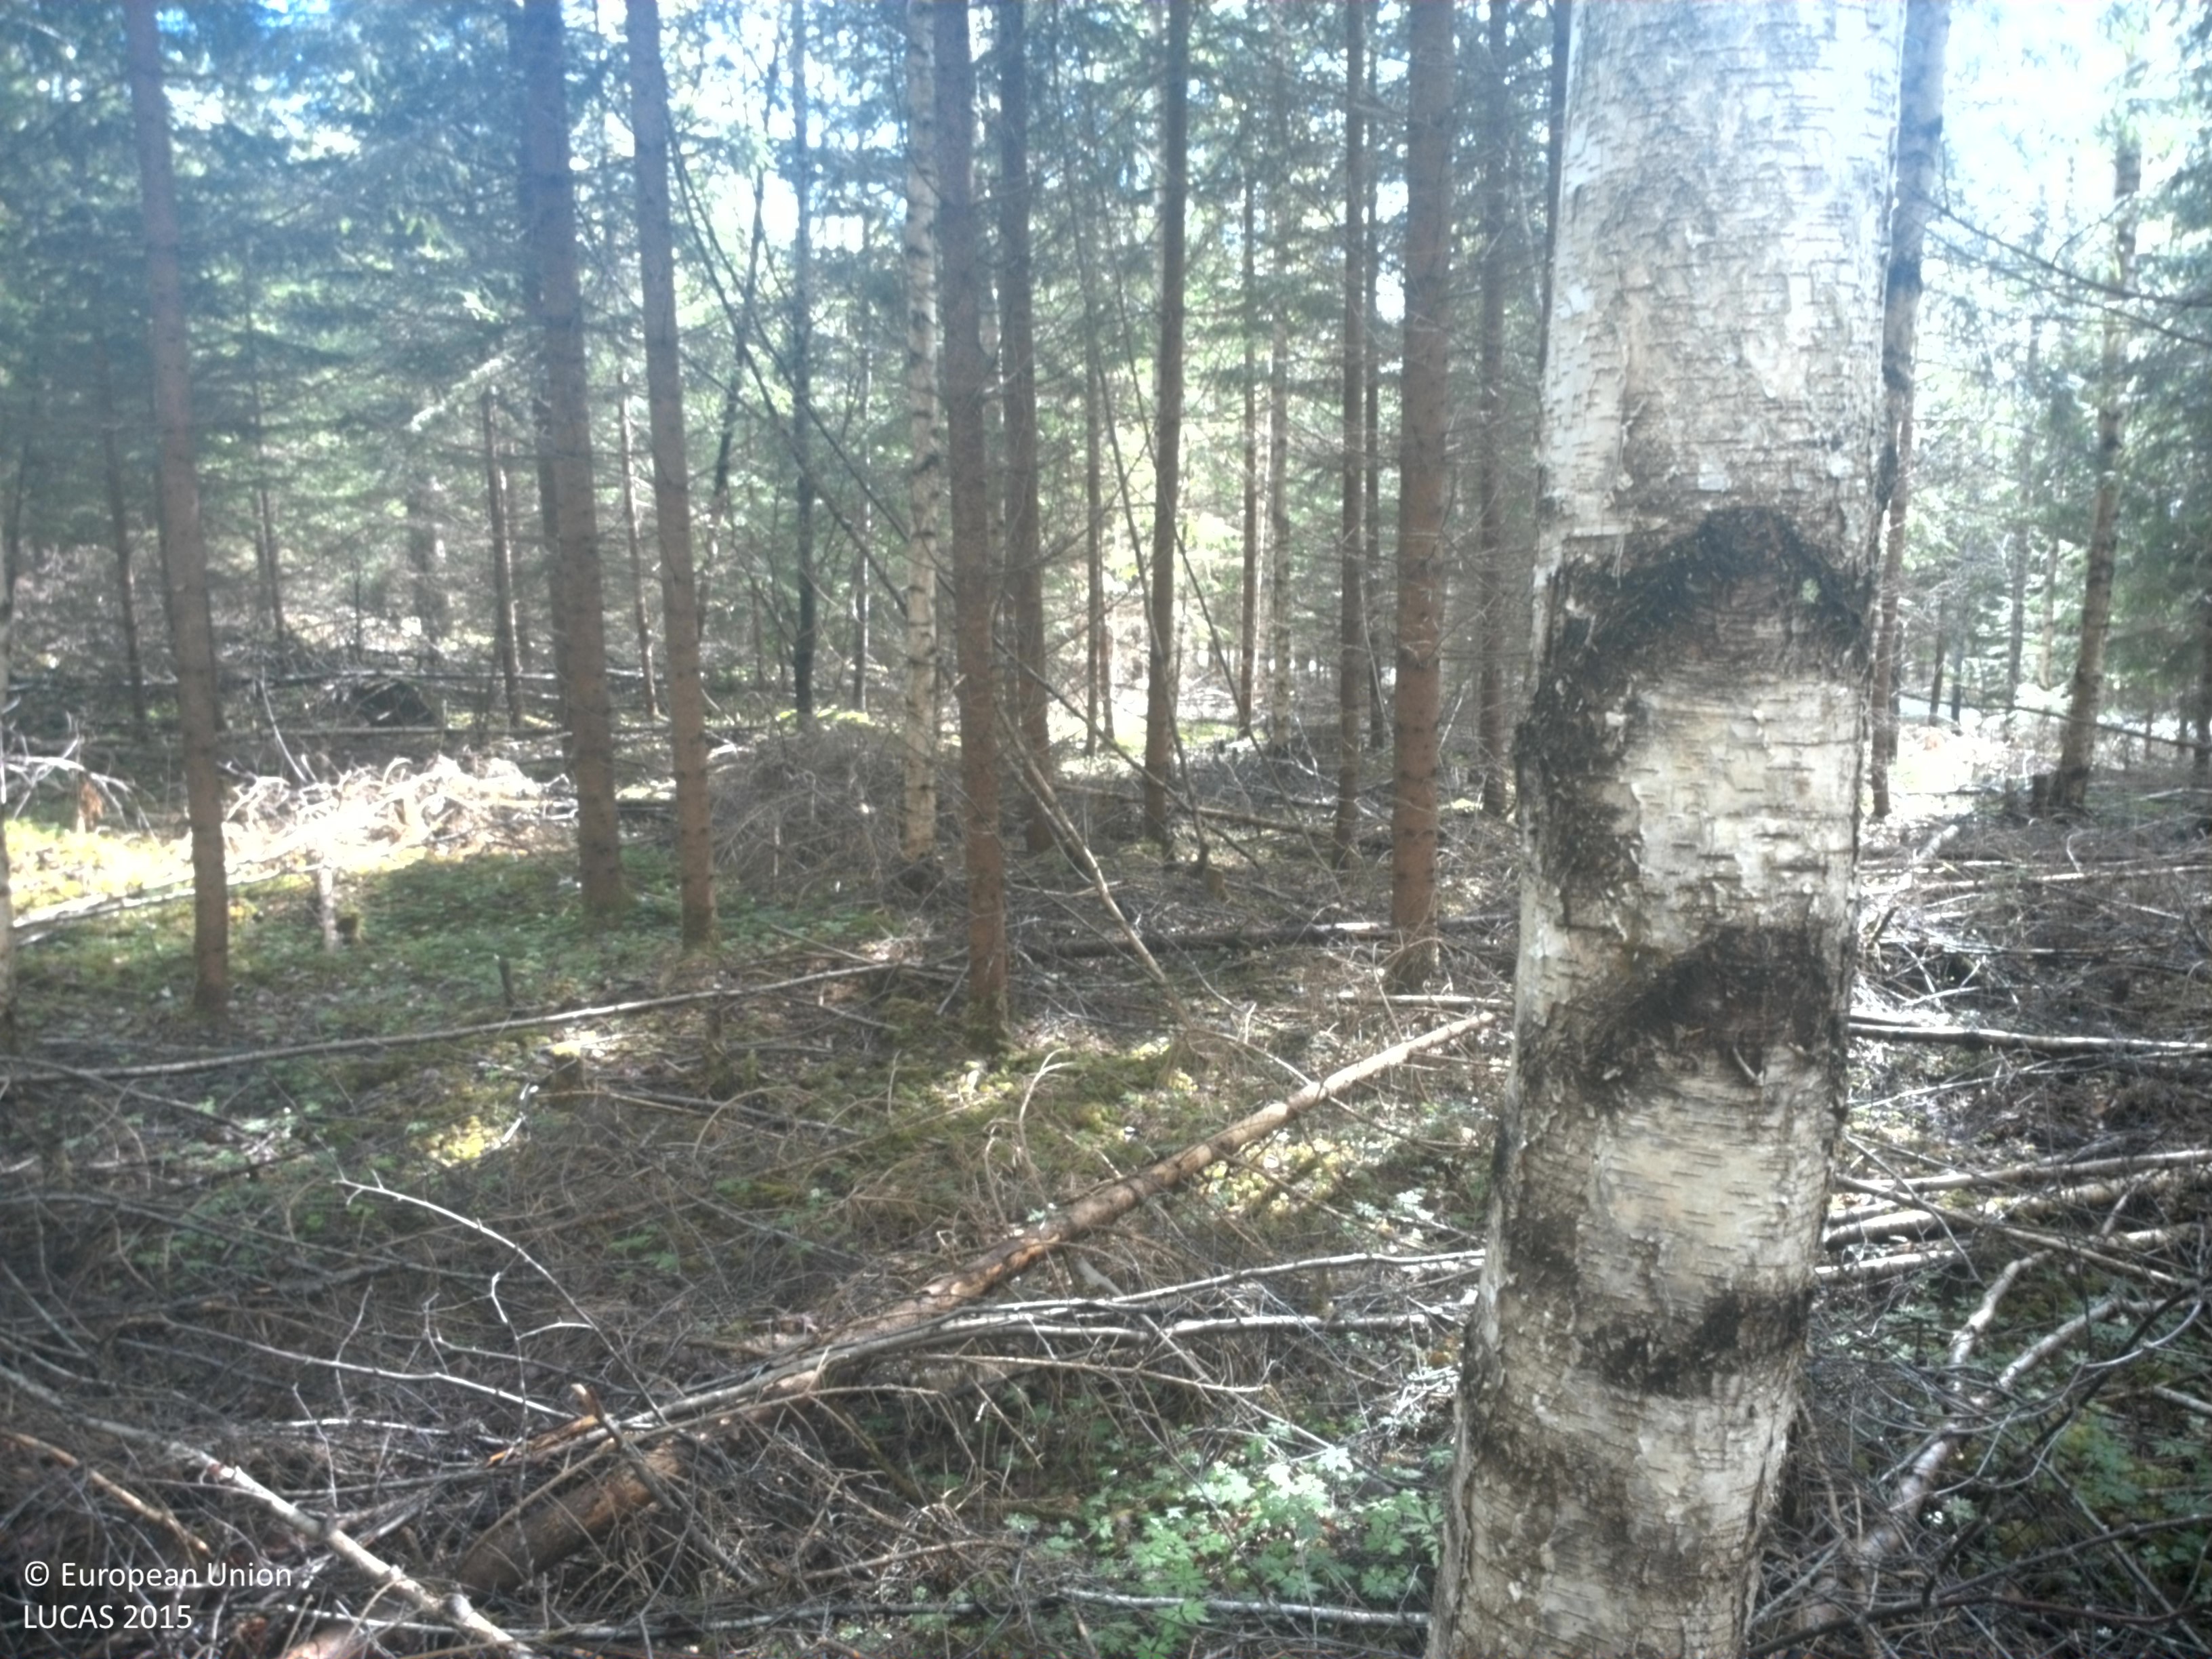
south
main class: Woodland
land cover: Broadleaved woodland
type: boreal forest
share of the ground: > 75 %
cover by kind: broadleaved forest trees 95 %, coniferous forest trees 5 %
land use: Forestry
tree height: > 5 m
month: May
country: SE
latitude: 59.5297
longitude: 12.4159
